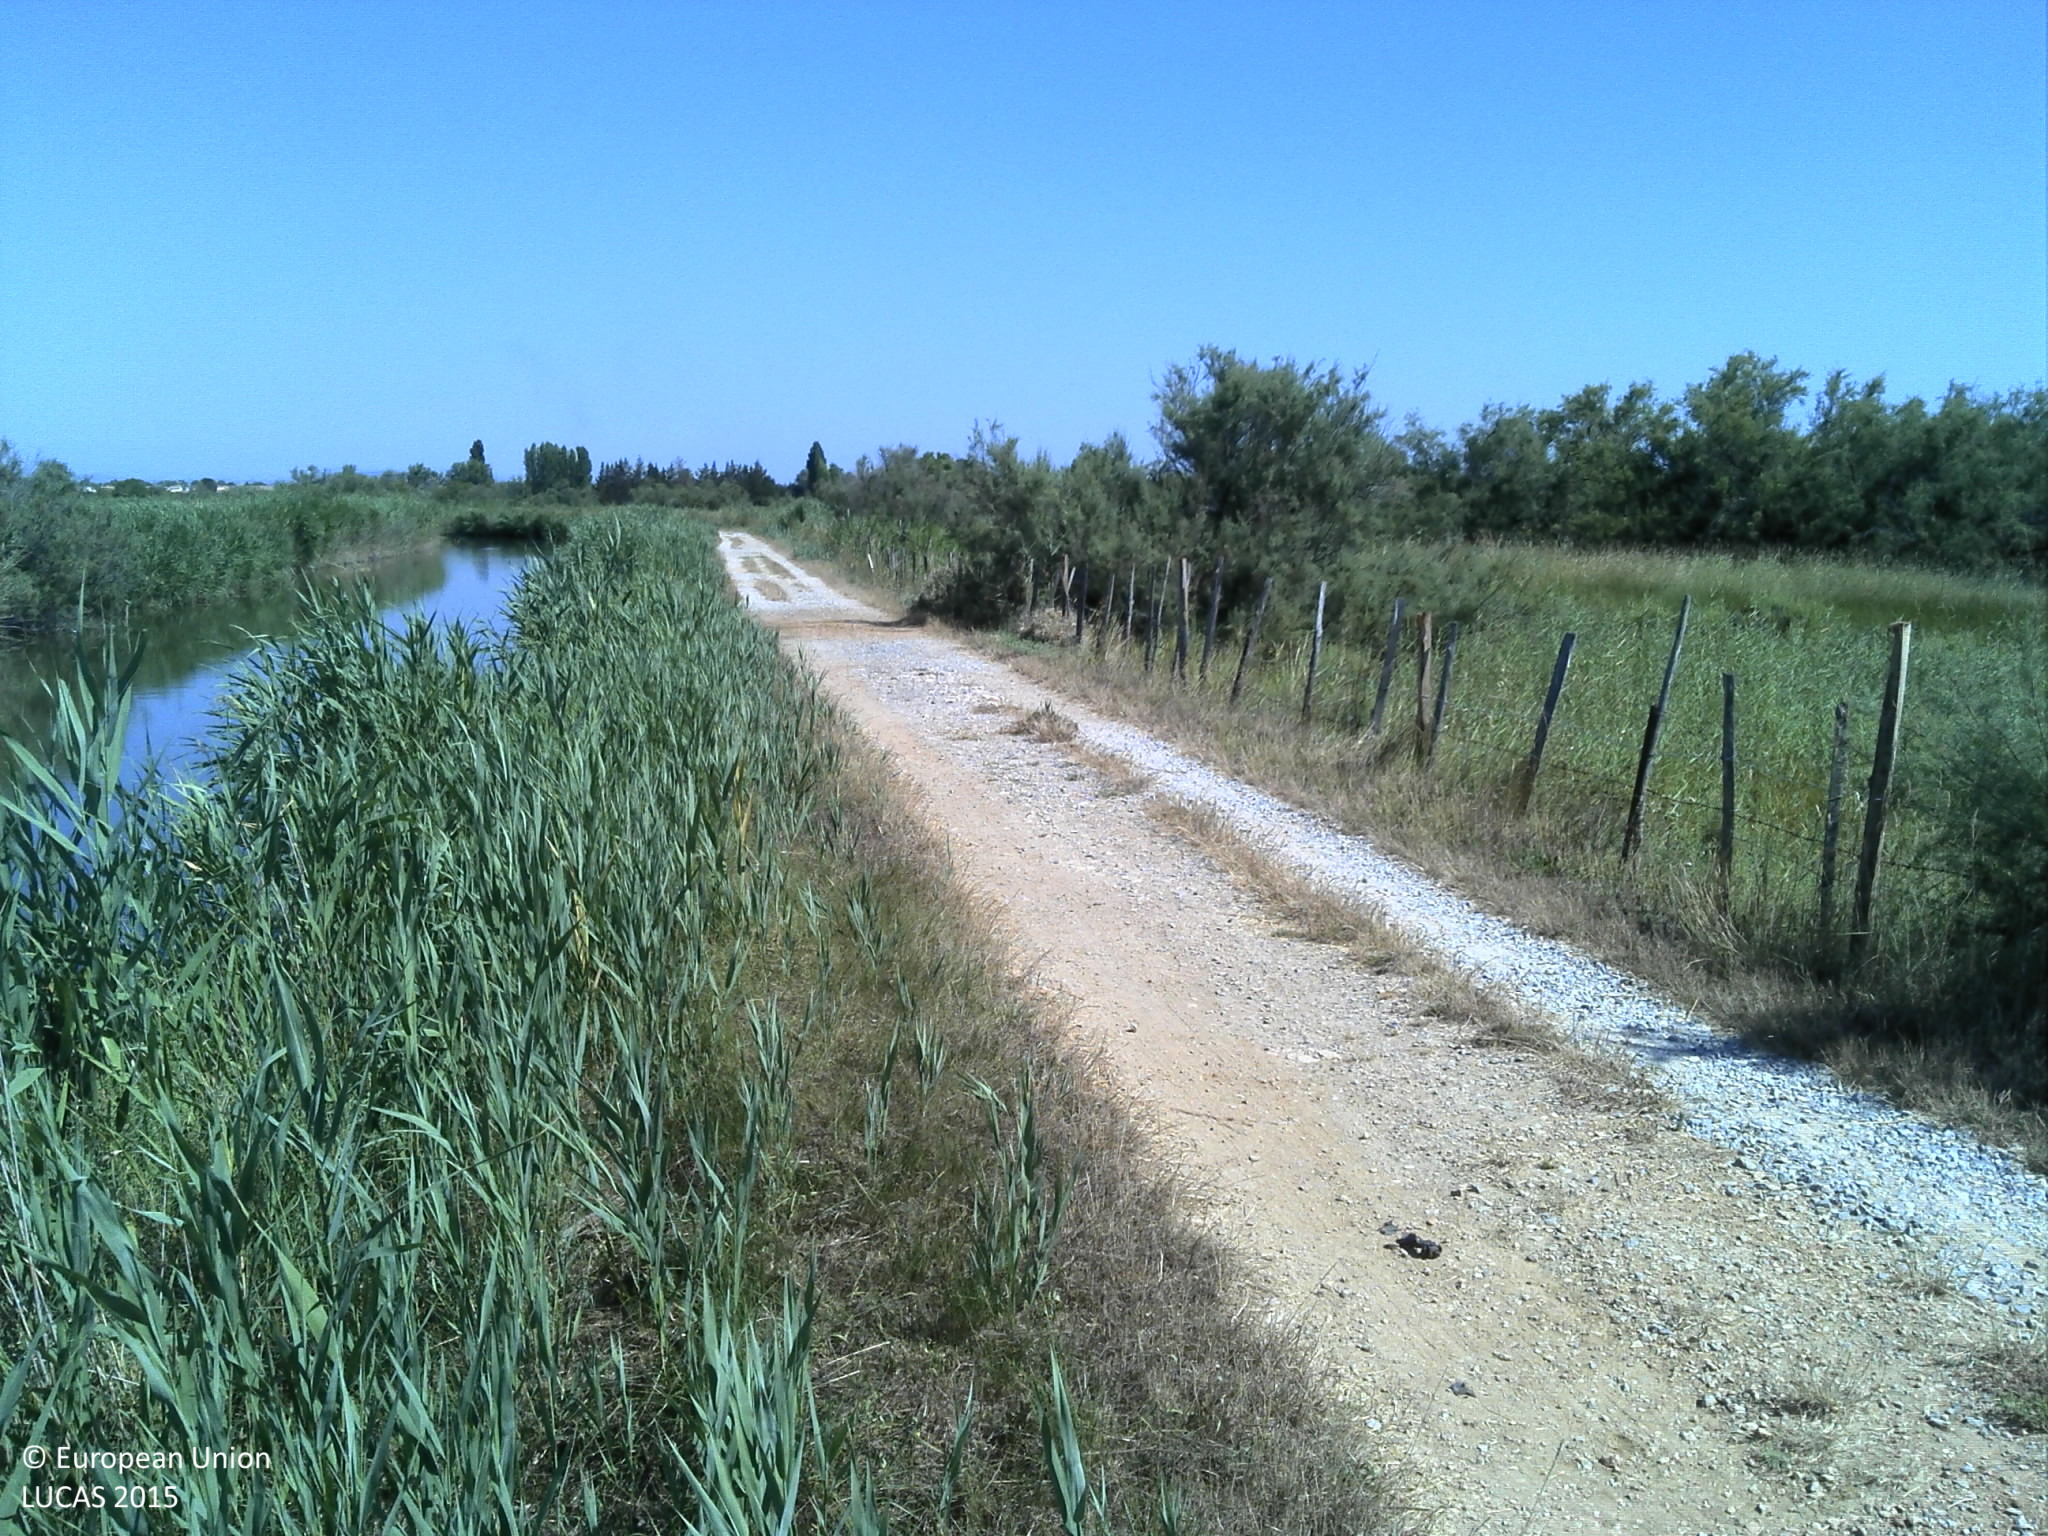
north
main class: Grassland
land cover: Spontaneously vegetated surfaces
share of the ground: > 75 %
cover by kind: herbaceous plants 100 %
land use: Semi-natural and natural areas not in use
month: July
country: FR
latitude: 43.5997
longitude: 4.0260
